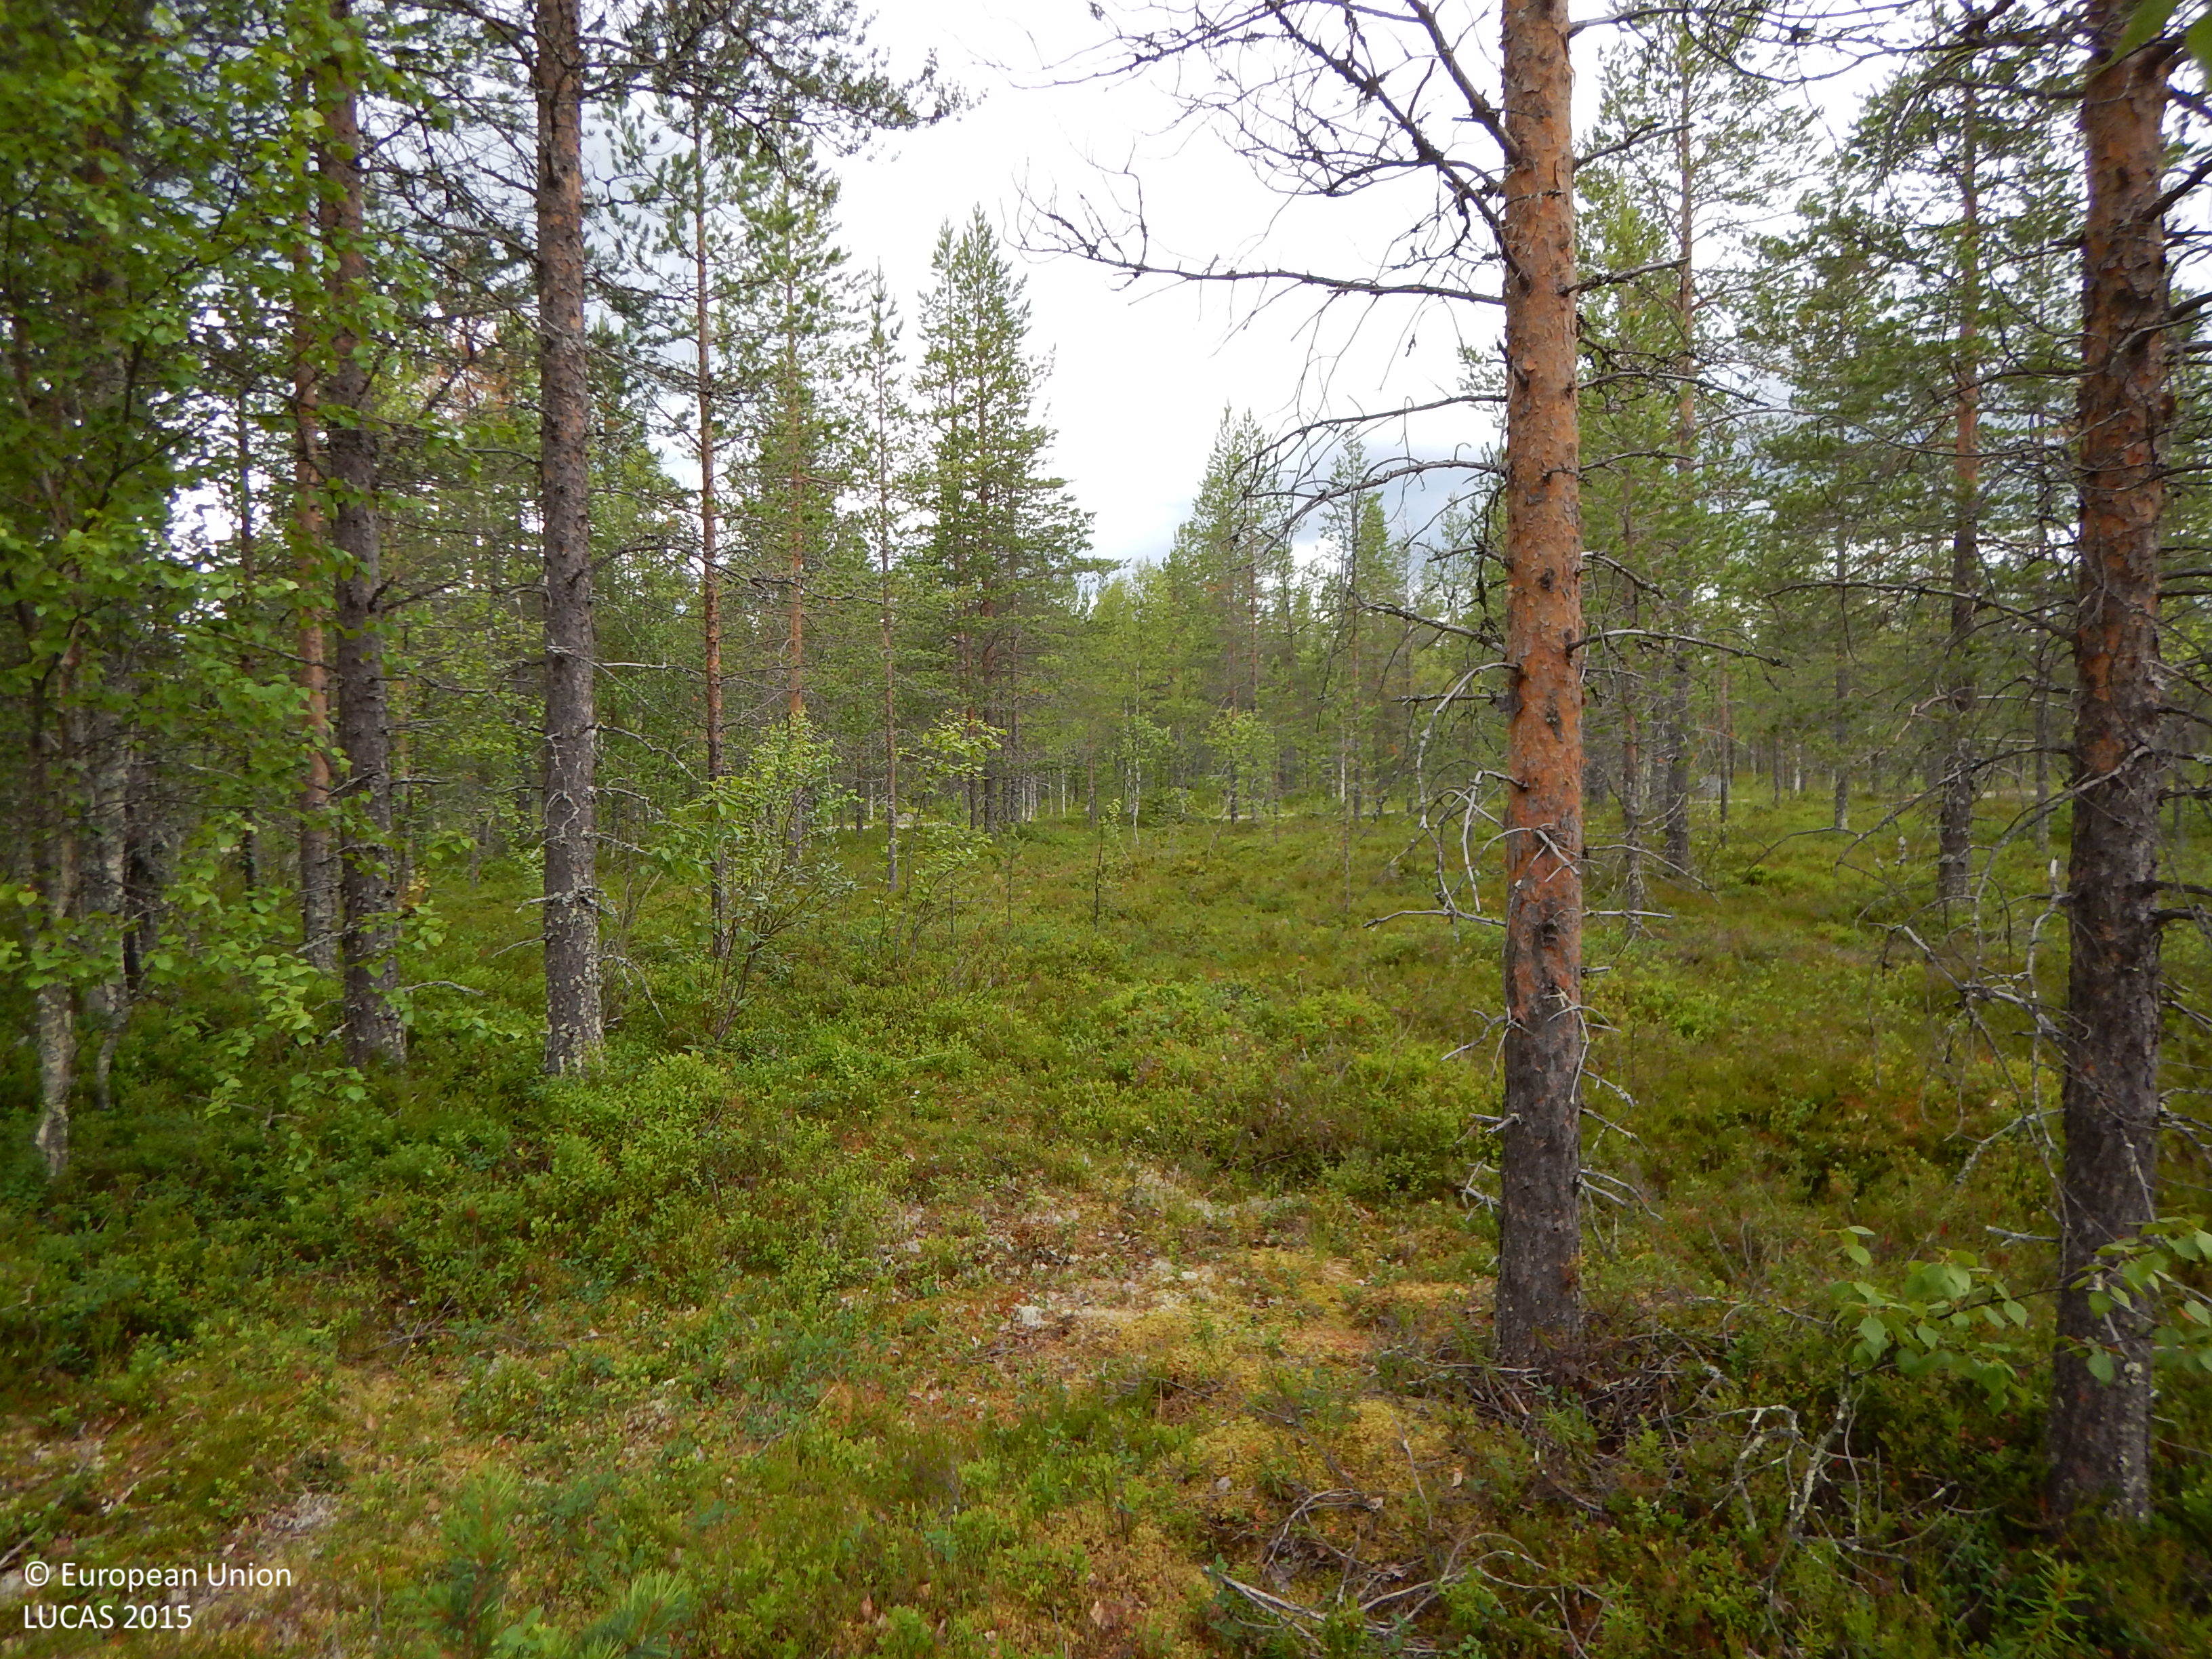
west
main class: Woodland
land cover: Pine dominated mixed woodland
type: boreal forest
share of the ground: 25 - 50 %
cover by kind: shrubs 35 %, coniferous forest trees 30 %, lichens and mosses 15 %, broadleaved forest trees 10 %, herbaceous plants 10 %
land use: Forestry
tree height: > 5 m
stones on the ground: < 10 %
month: July
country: SE
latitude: 65.0111
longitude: 20.3028
